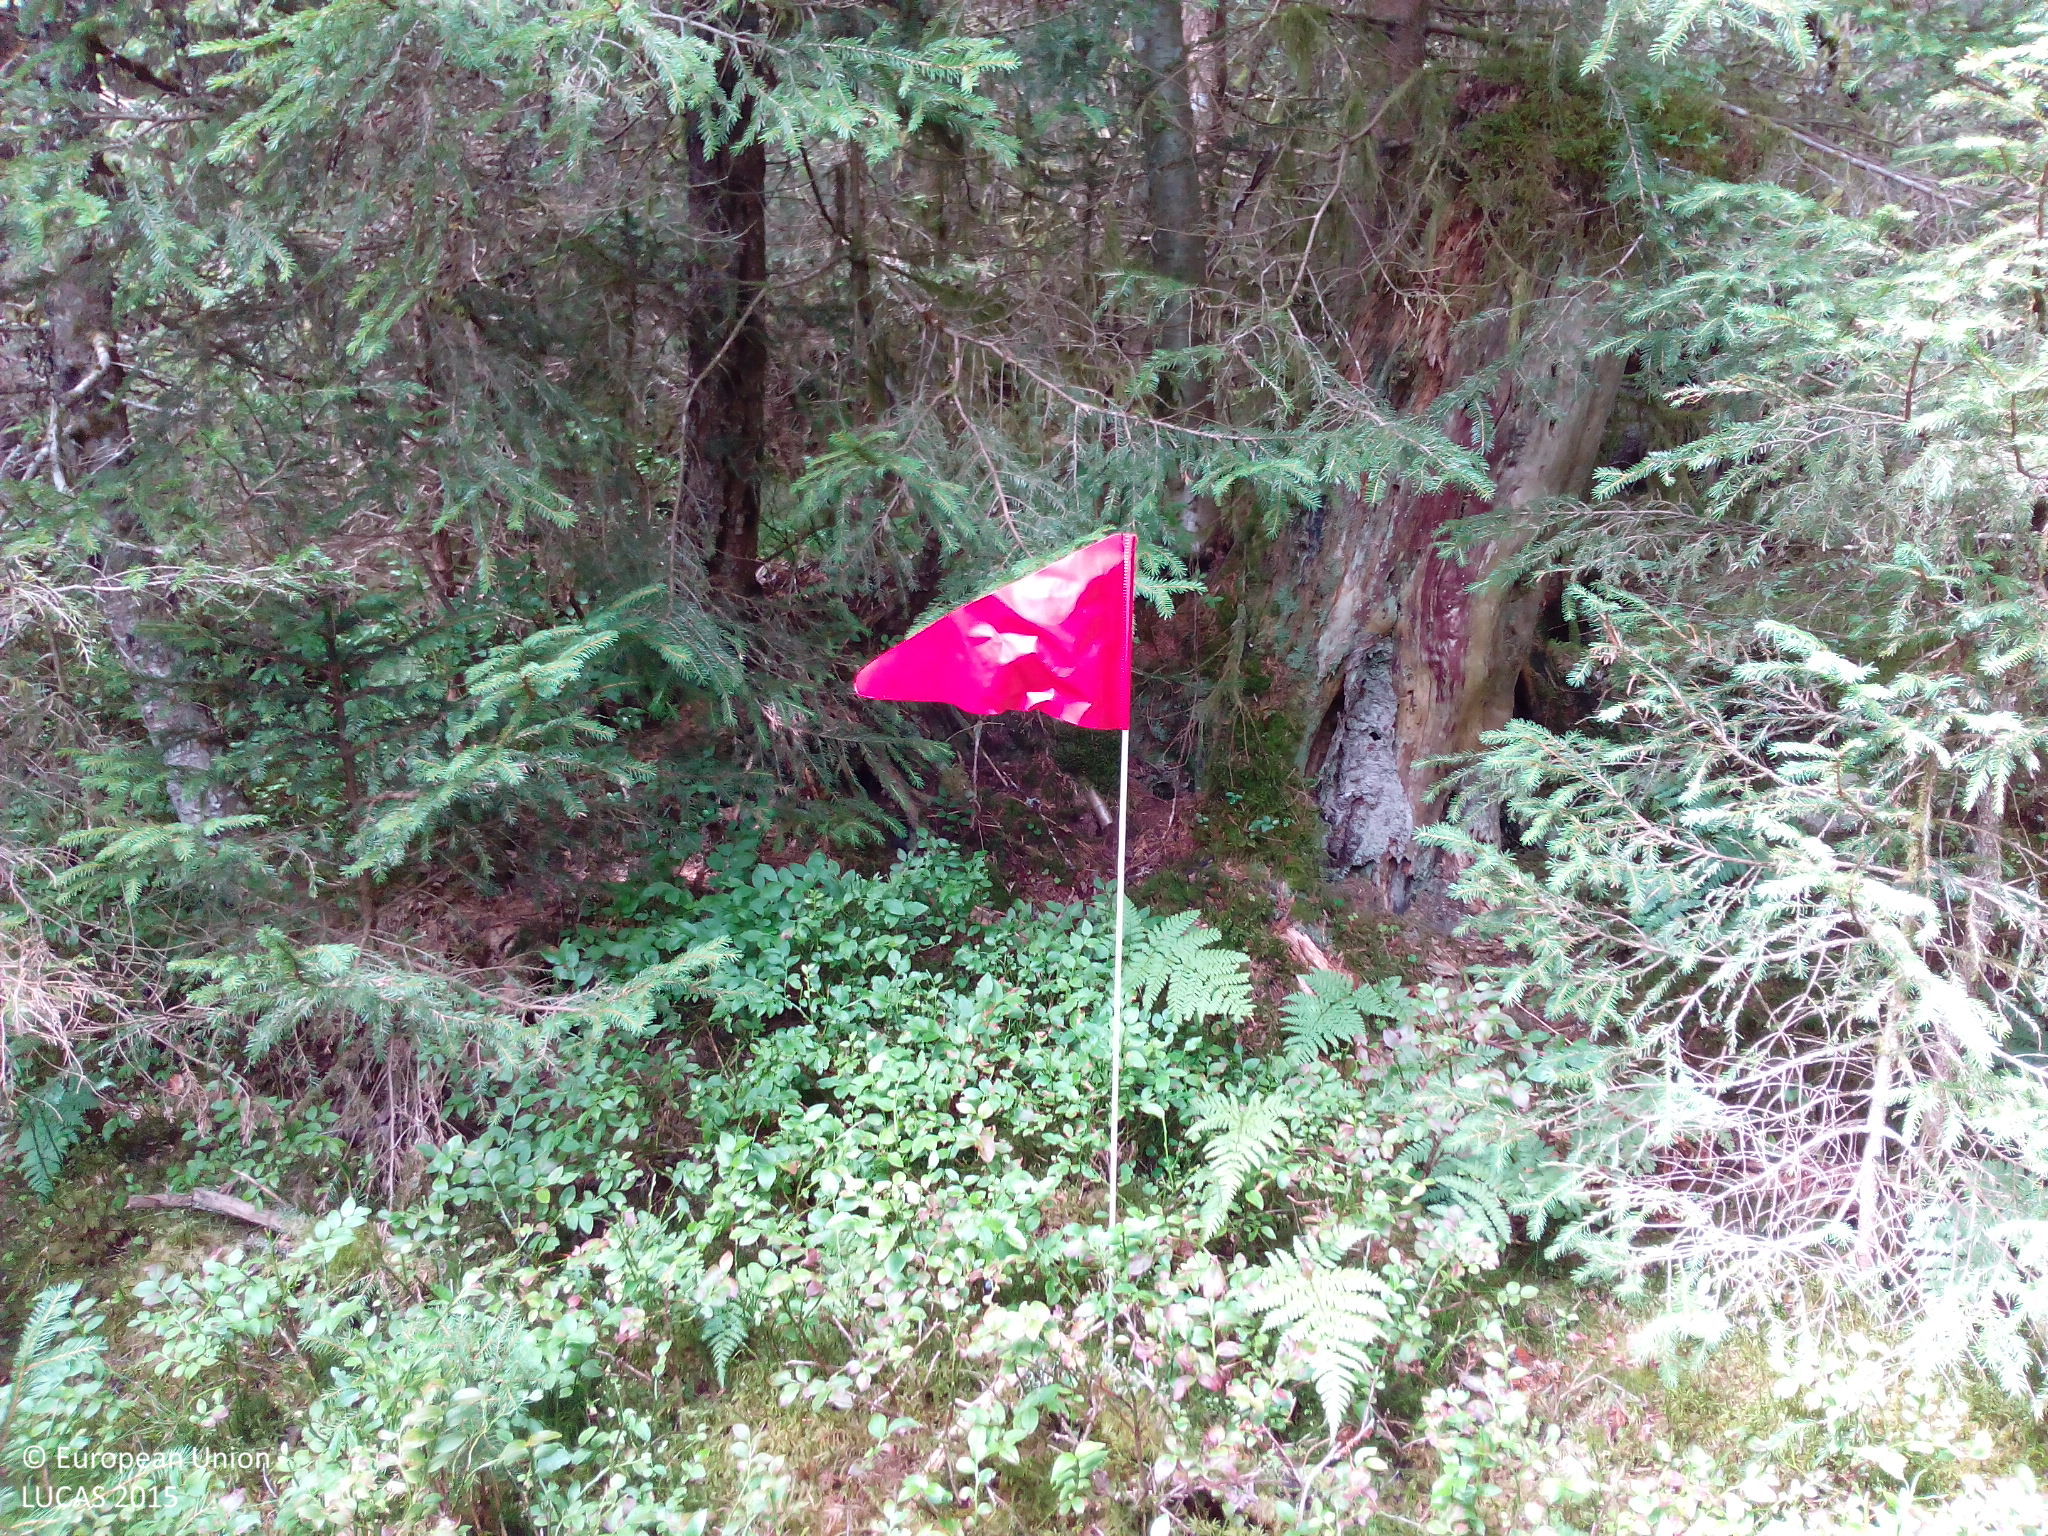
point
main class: Woodland
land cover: Spruce dominated coniferous woodland
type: hemiboreal forest and nemoral coniferous forest and mixed broadleaved-coniferous forest
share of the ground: > 75 %
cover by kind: coniferous forest trees 80 %, shrubs 10 %, lichens and mosses 10 %
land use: Semi-natural and natural areas not in use
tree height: > 5 m
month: August
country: DE
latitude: 47.7768
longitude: 8.1996
